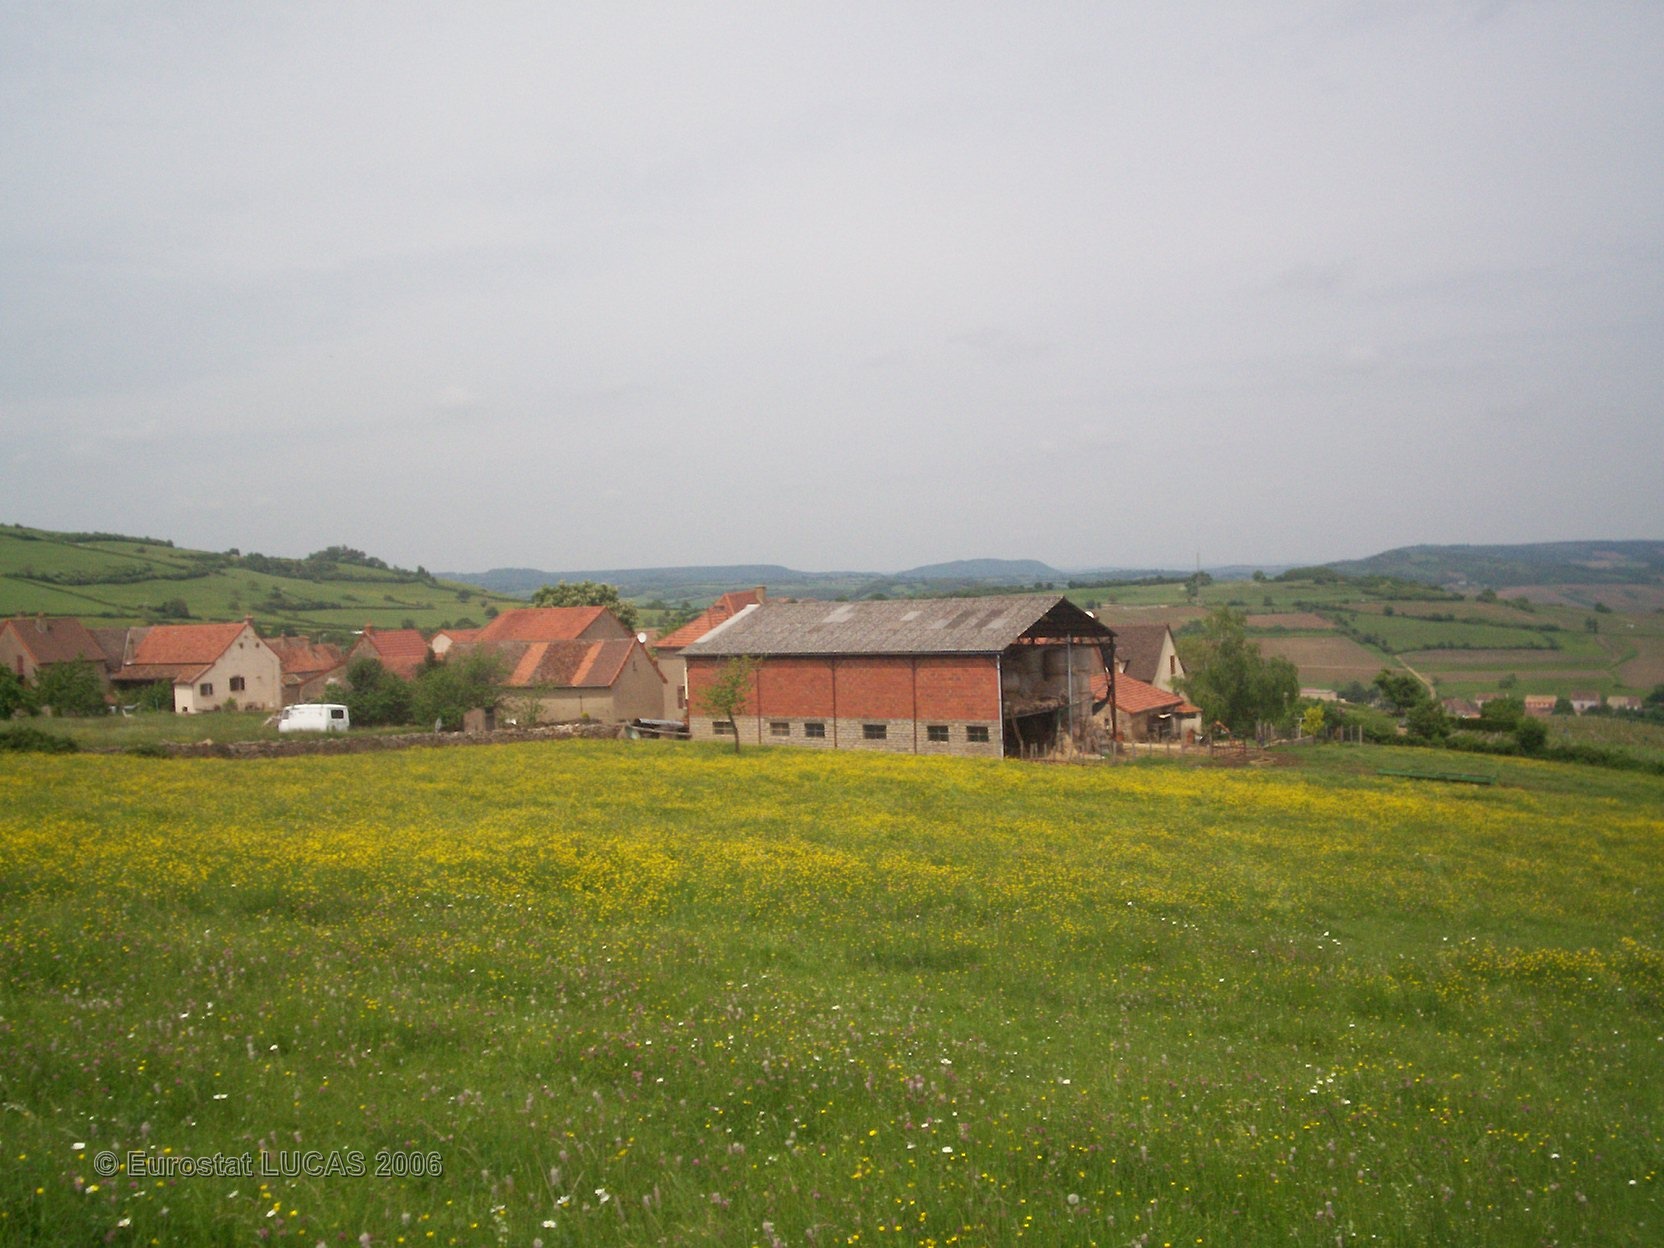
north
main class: Grassland
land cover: Grassland without tree/shrub cover
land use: Agriculture (excluding fallow land and kitchen gardens)
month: May
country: FR
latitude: 46.7240
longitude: 4.6759
